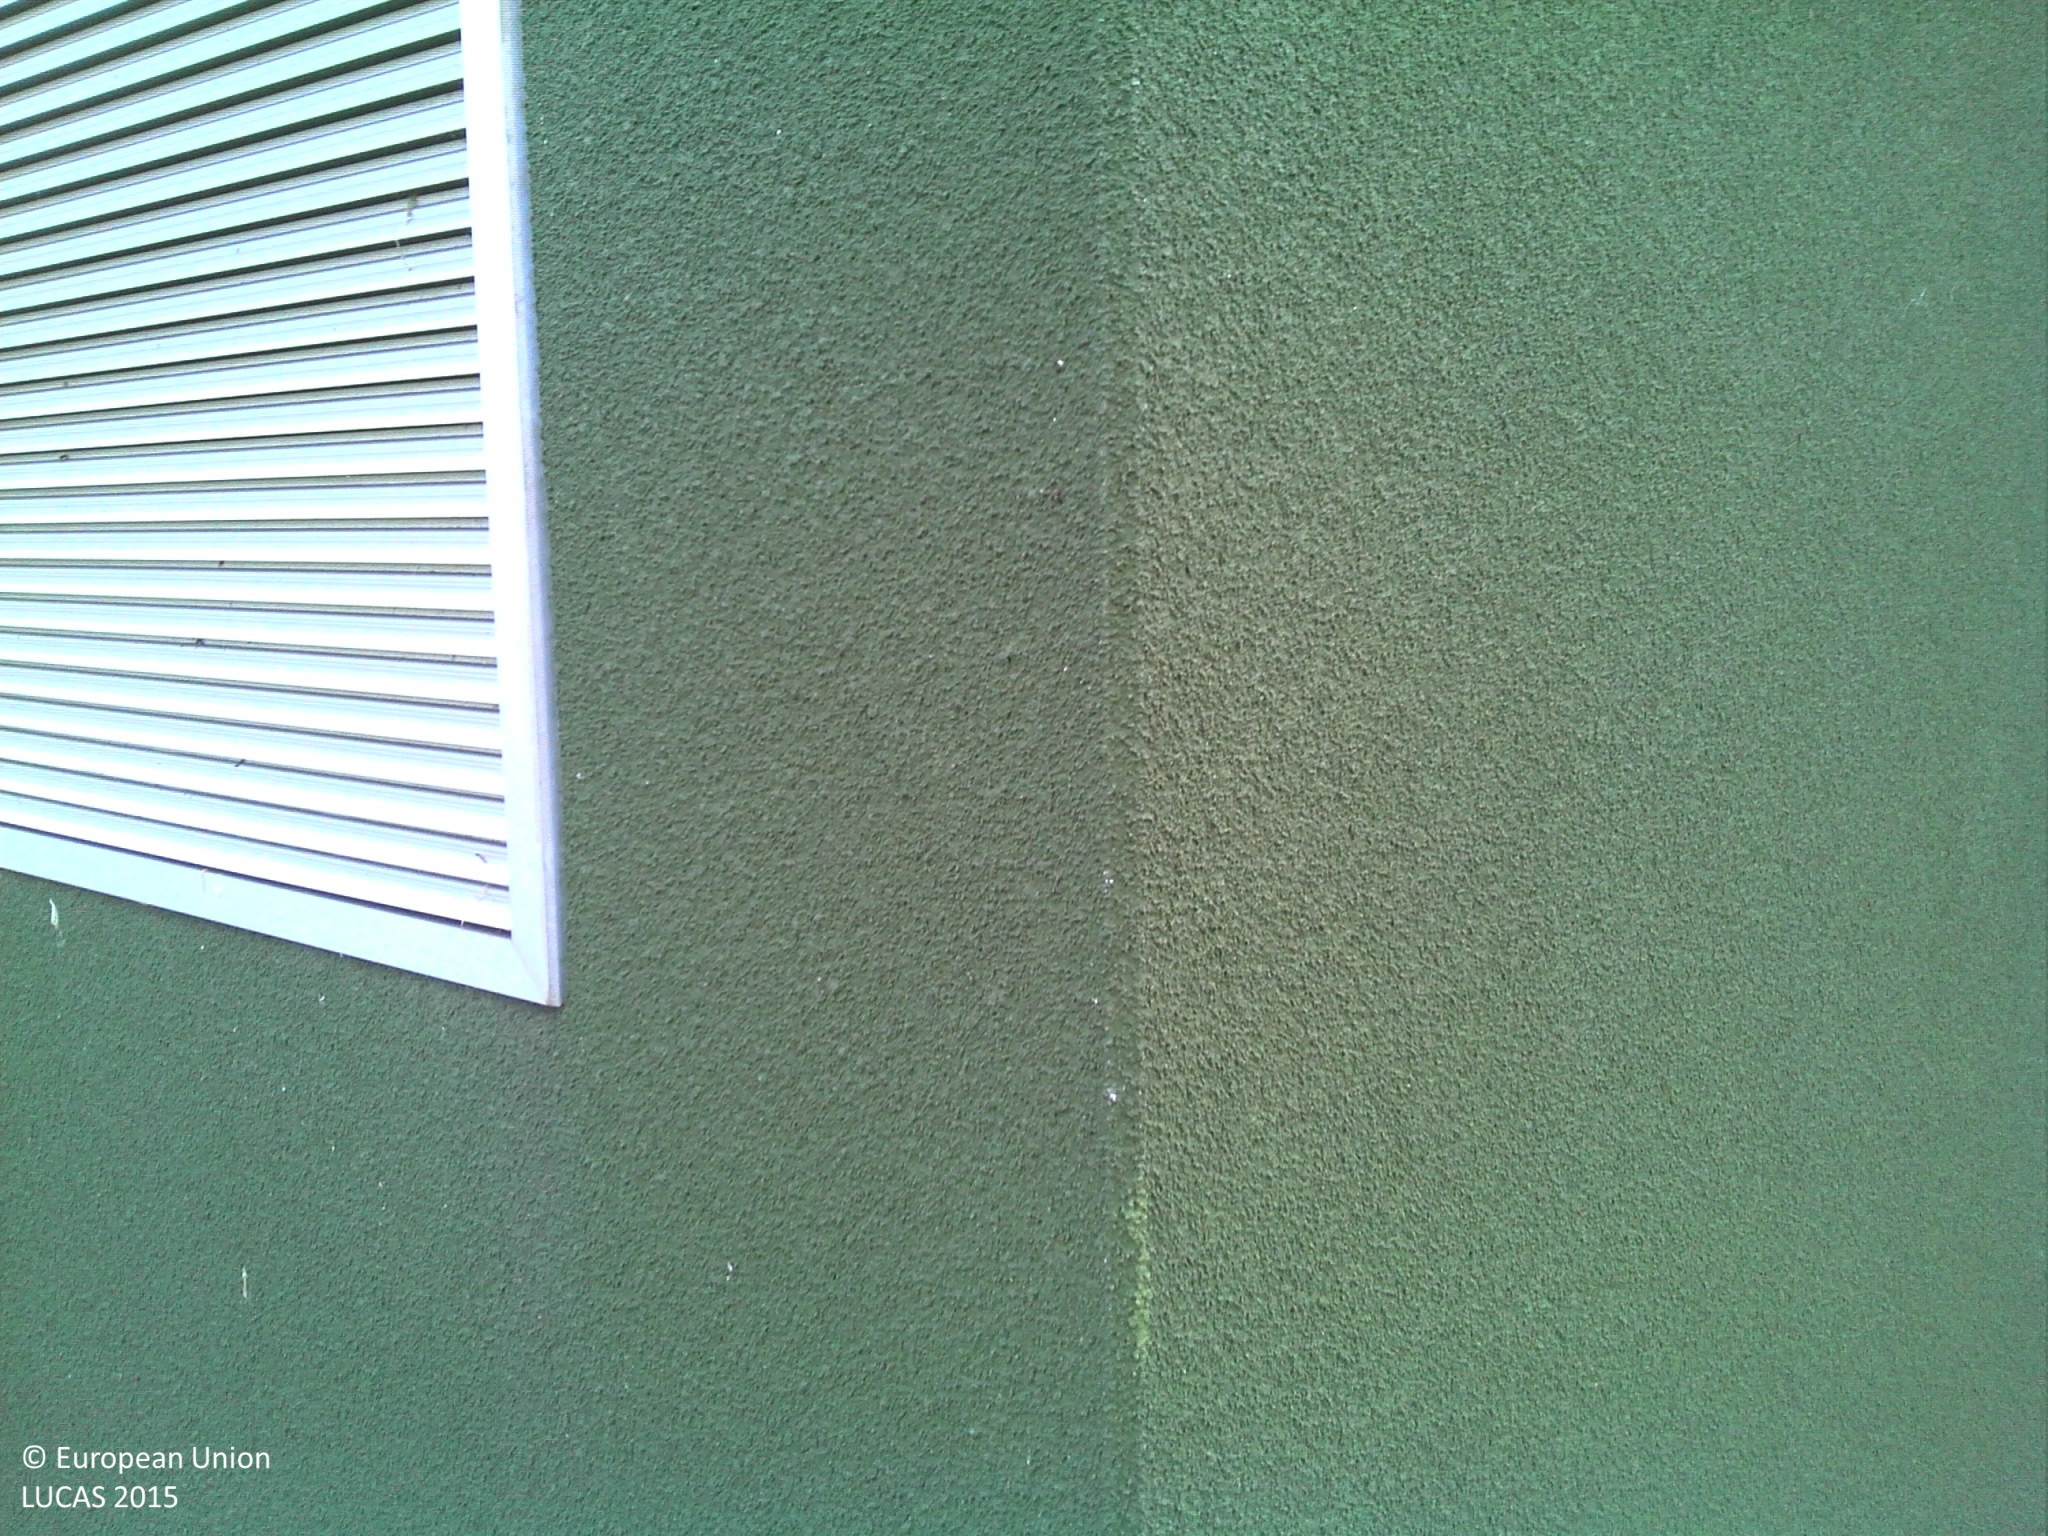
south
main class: Grassland
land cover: Spontaneously vegetated surfaces
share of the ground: > 75 %
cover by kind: herbaceous plants 80 %, unconsolidated bare surface 20 %
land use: Energy production
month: August
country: BE
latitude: 50.9361
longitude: 3.1745
